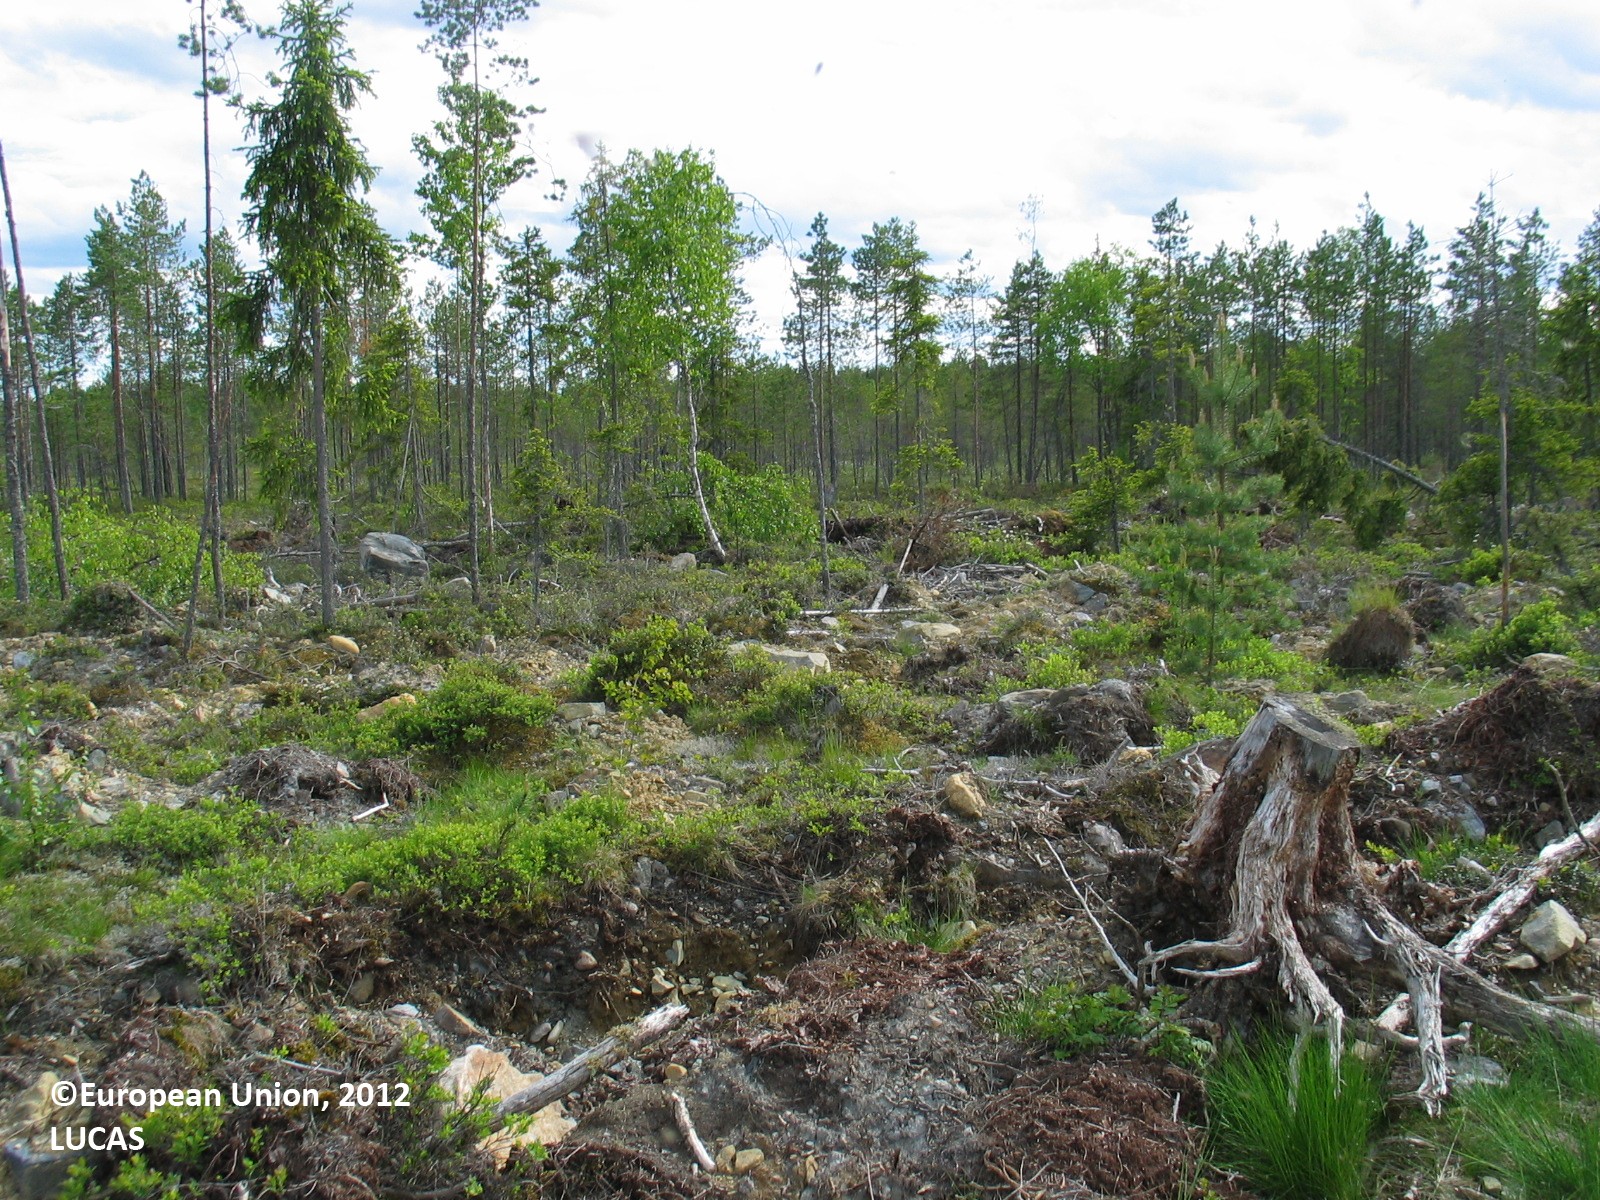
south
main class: Shrubland
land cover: Shrubland without tree cover
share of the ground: 25 - 50 %
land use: Forestry
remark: Clear cut
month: June
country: FI
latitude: 64.8955
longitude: 26.5236
